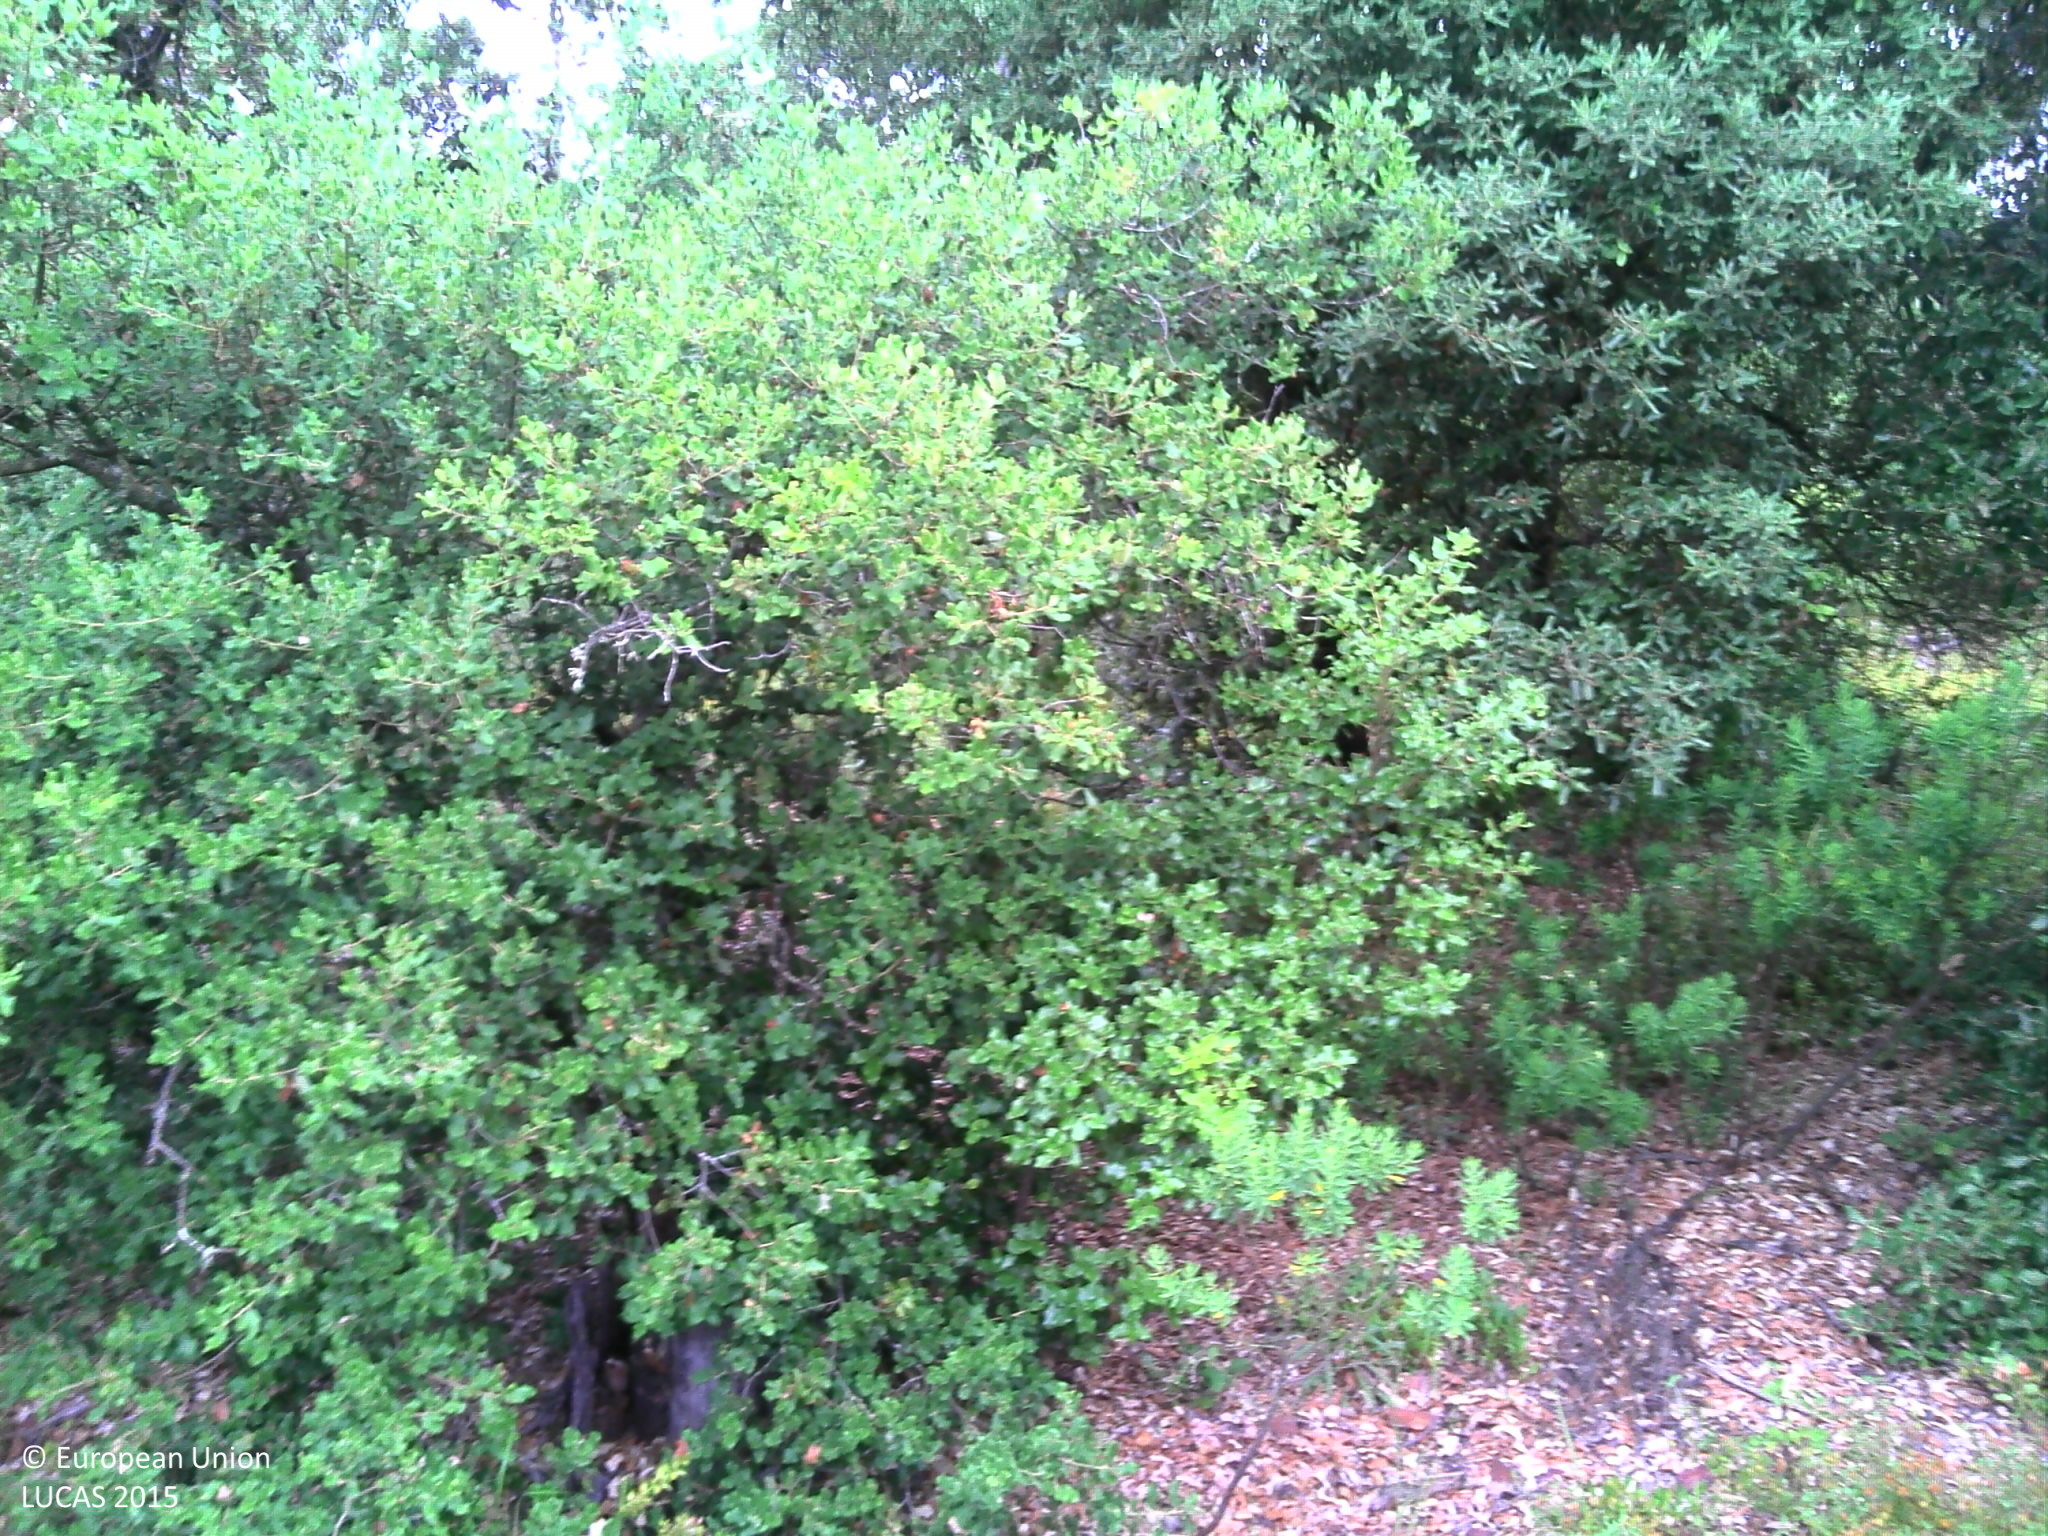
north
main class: Woodland
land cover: Pine dominated mixed woodland
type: coniferous forest of the mediterranean region
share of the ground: > 75 %
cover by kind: coniferous forest trees 75 %, broadleaved forest trees 25 %
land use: Forestry
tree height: > 5 m
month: June
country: FR
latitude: 45.6593
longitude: -1.1303
